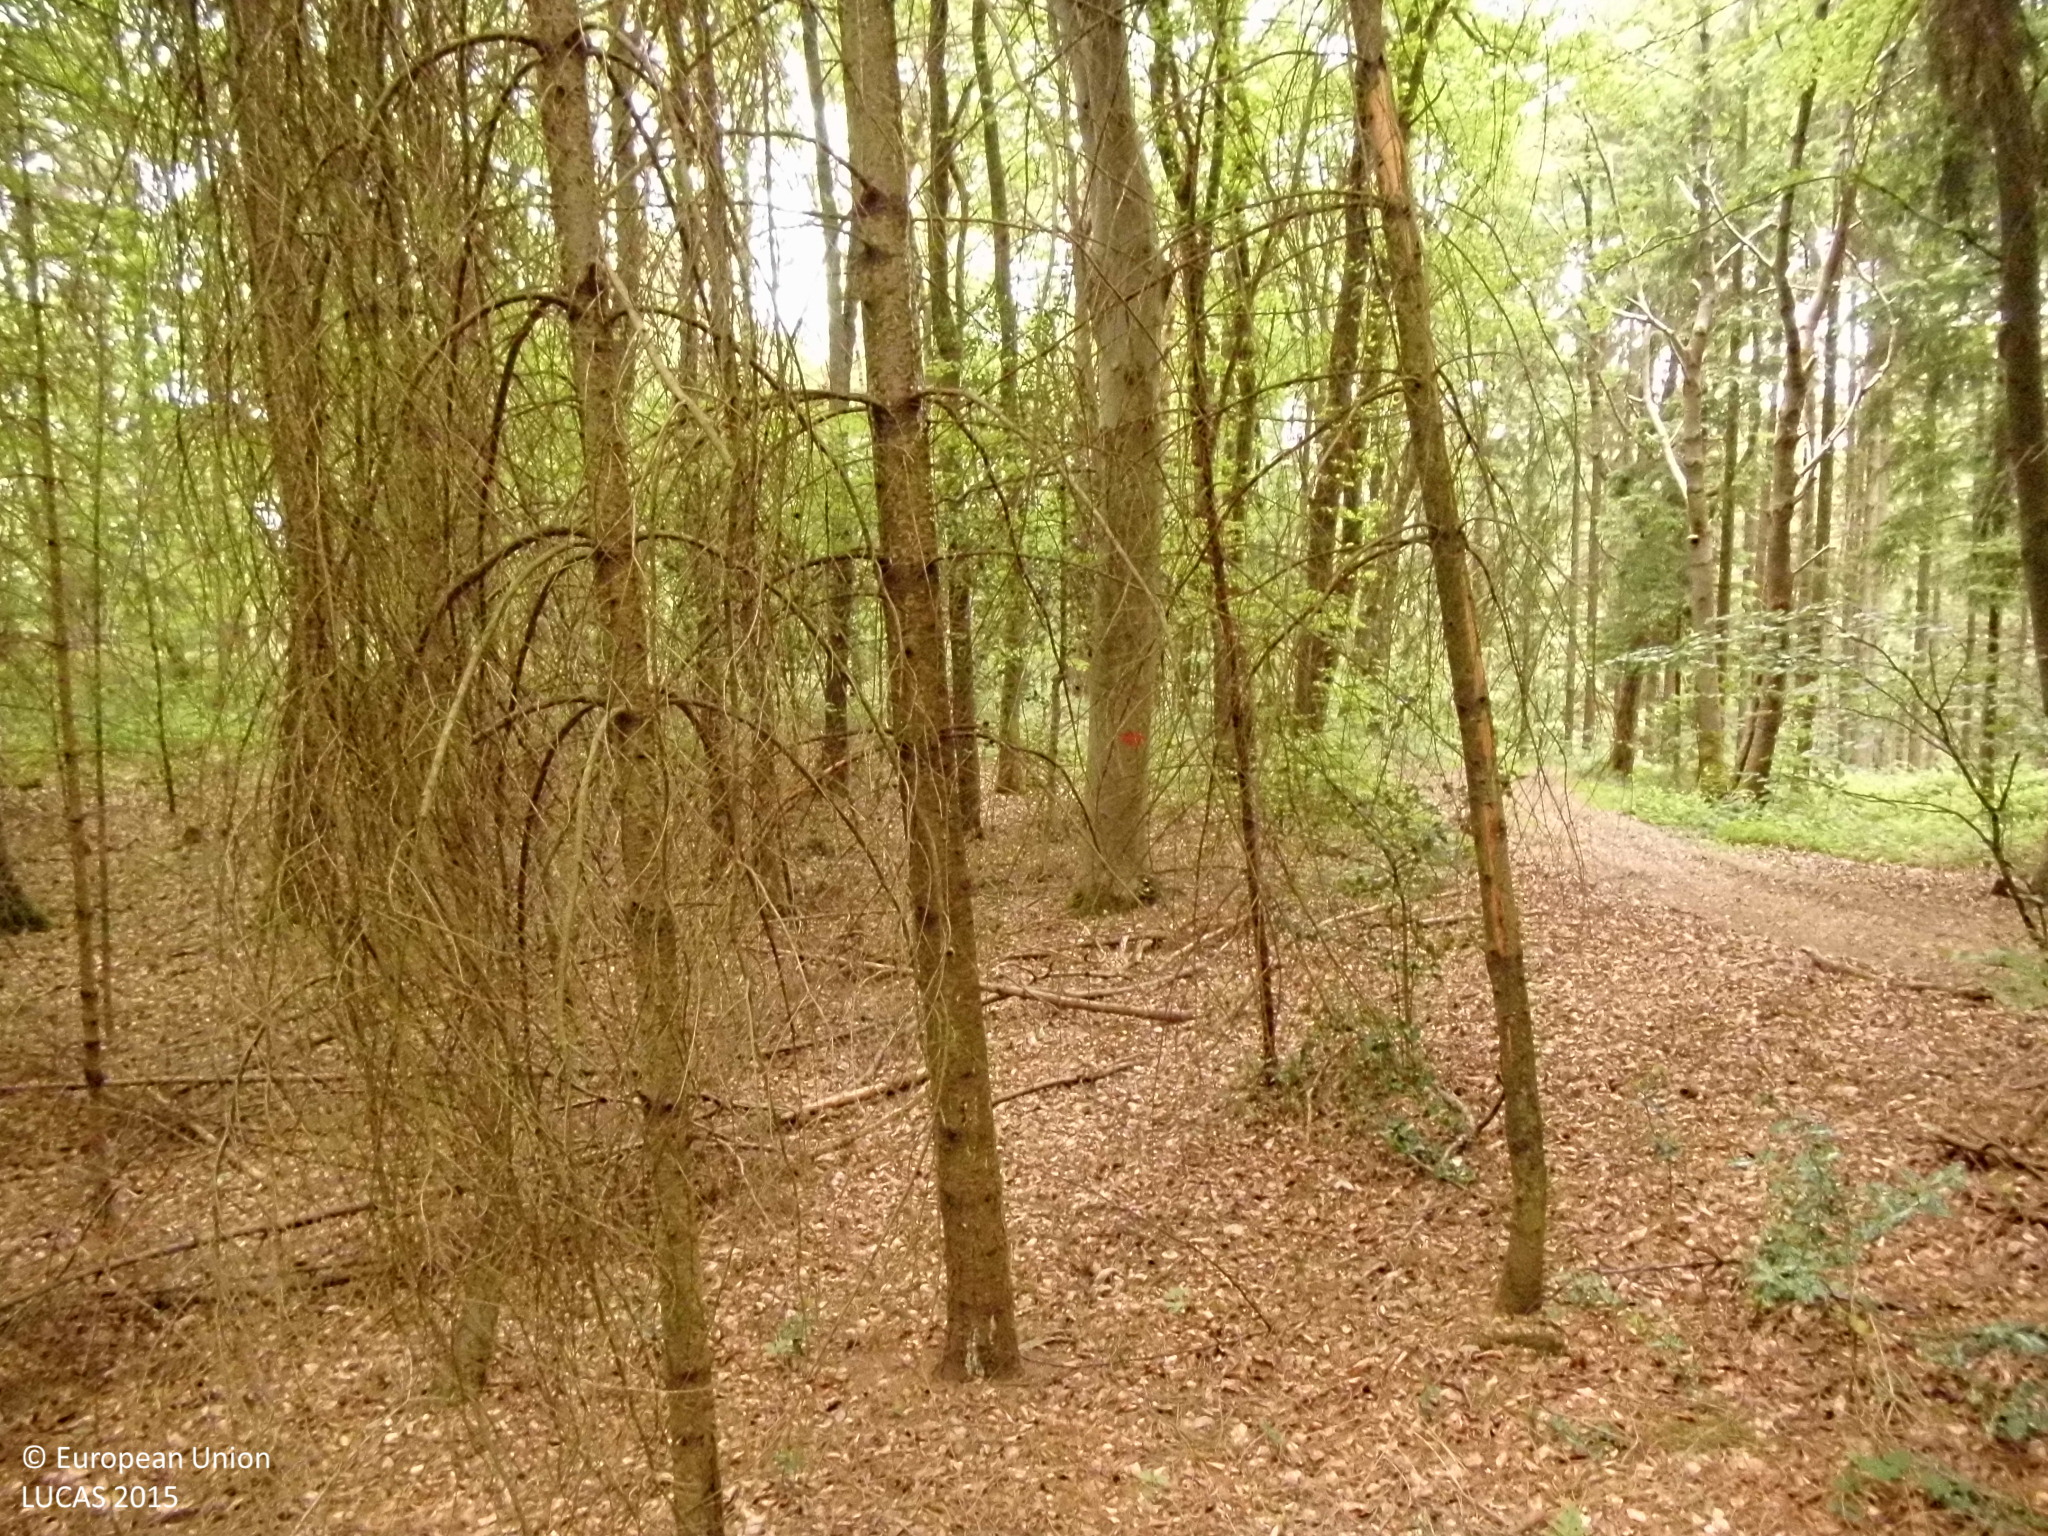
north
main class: Woodland
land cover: Other mixed woodland
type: hemiboreal forest and nemoral coniferous forest and mixed broadleaved-coniferous forest
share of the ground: > 75 %
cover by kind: coniferous forest trees 60 %, broadleaved forest trees 25 %, herbaceous plants 10 %, lichens and mosses 5 %
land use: Forestry
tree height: > 5 m
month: May
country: DE
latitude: 50.7503
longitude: 7.4915
